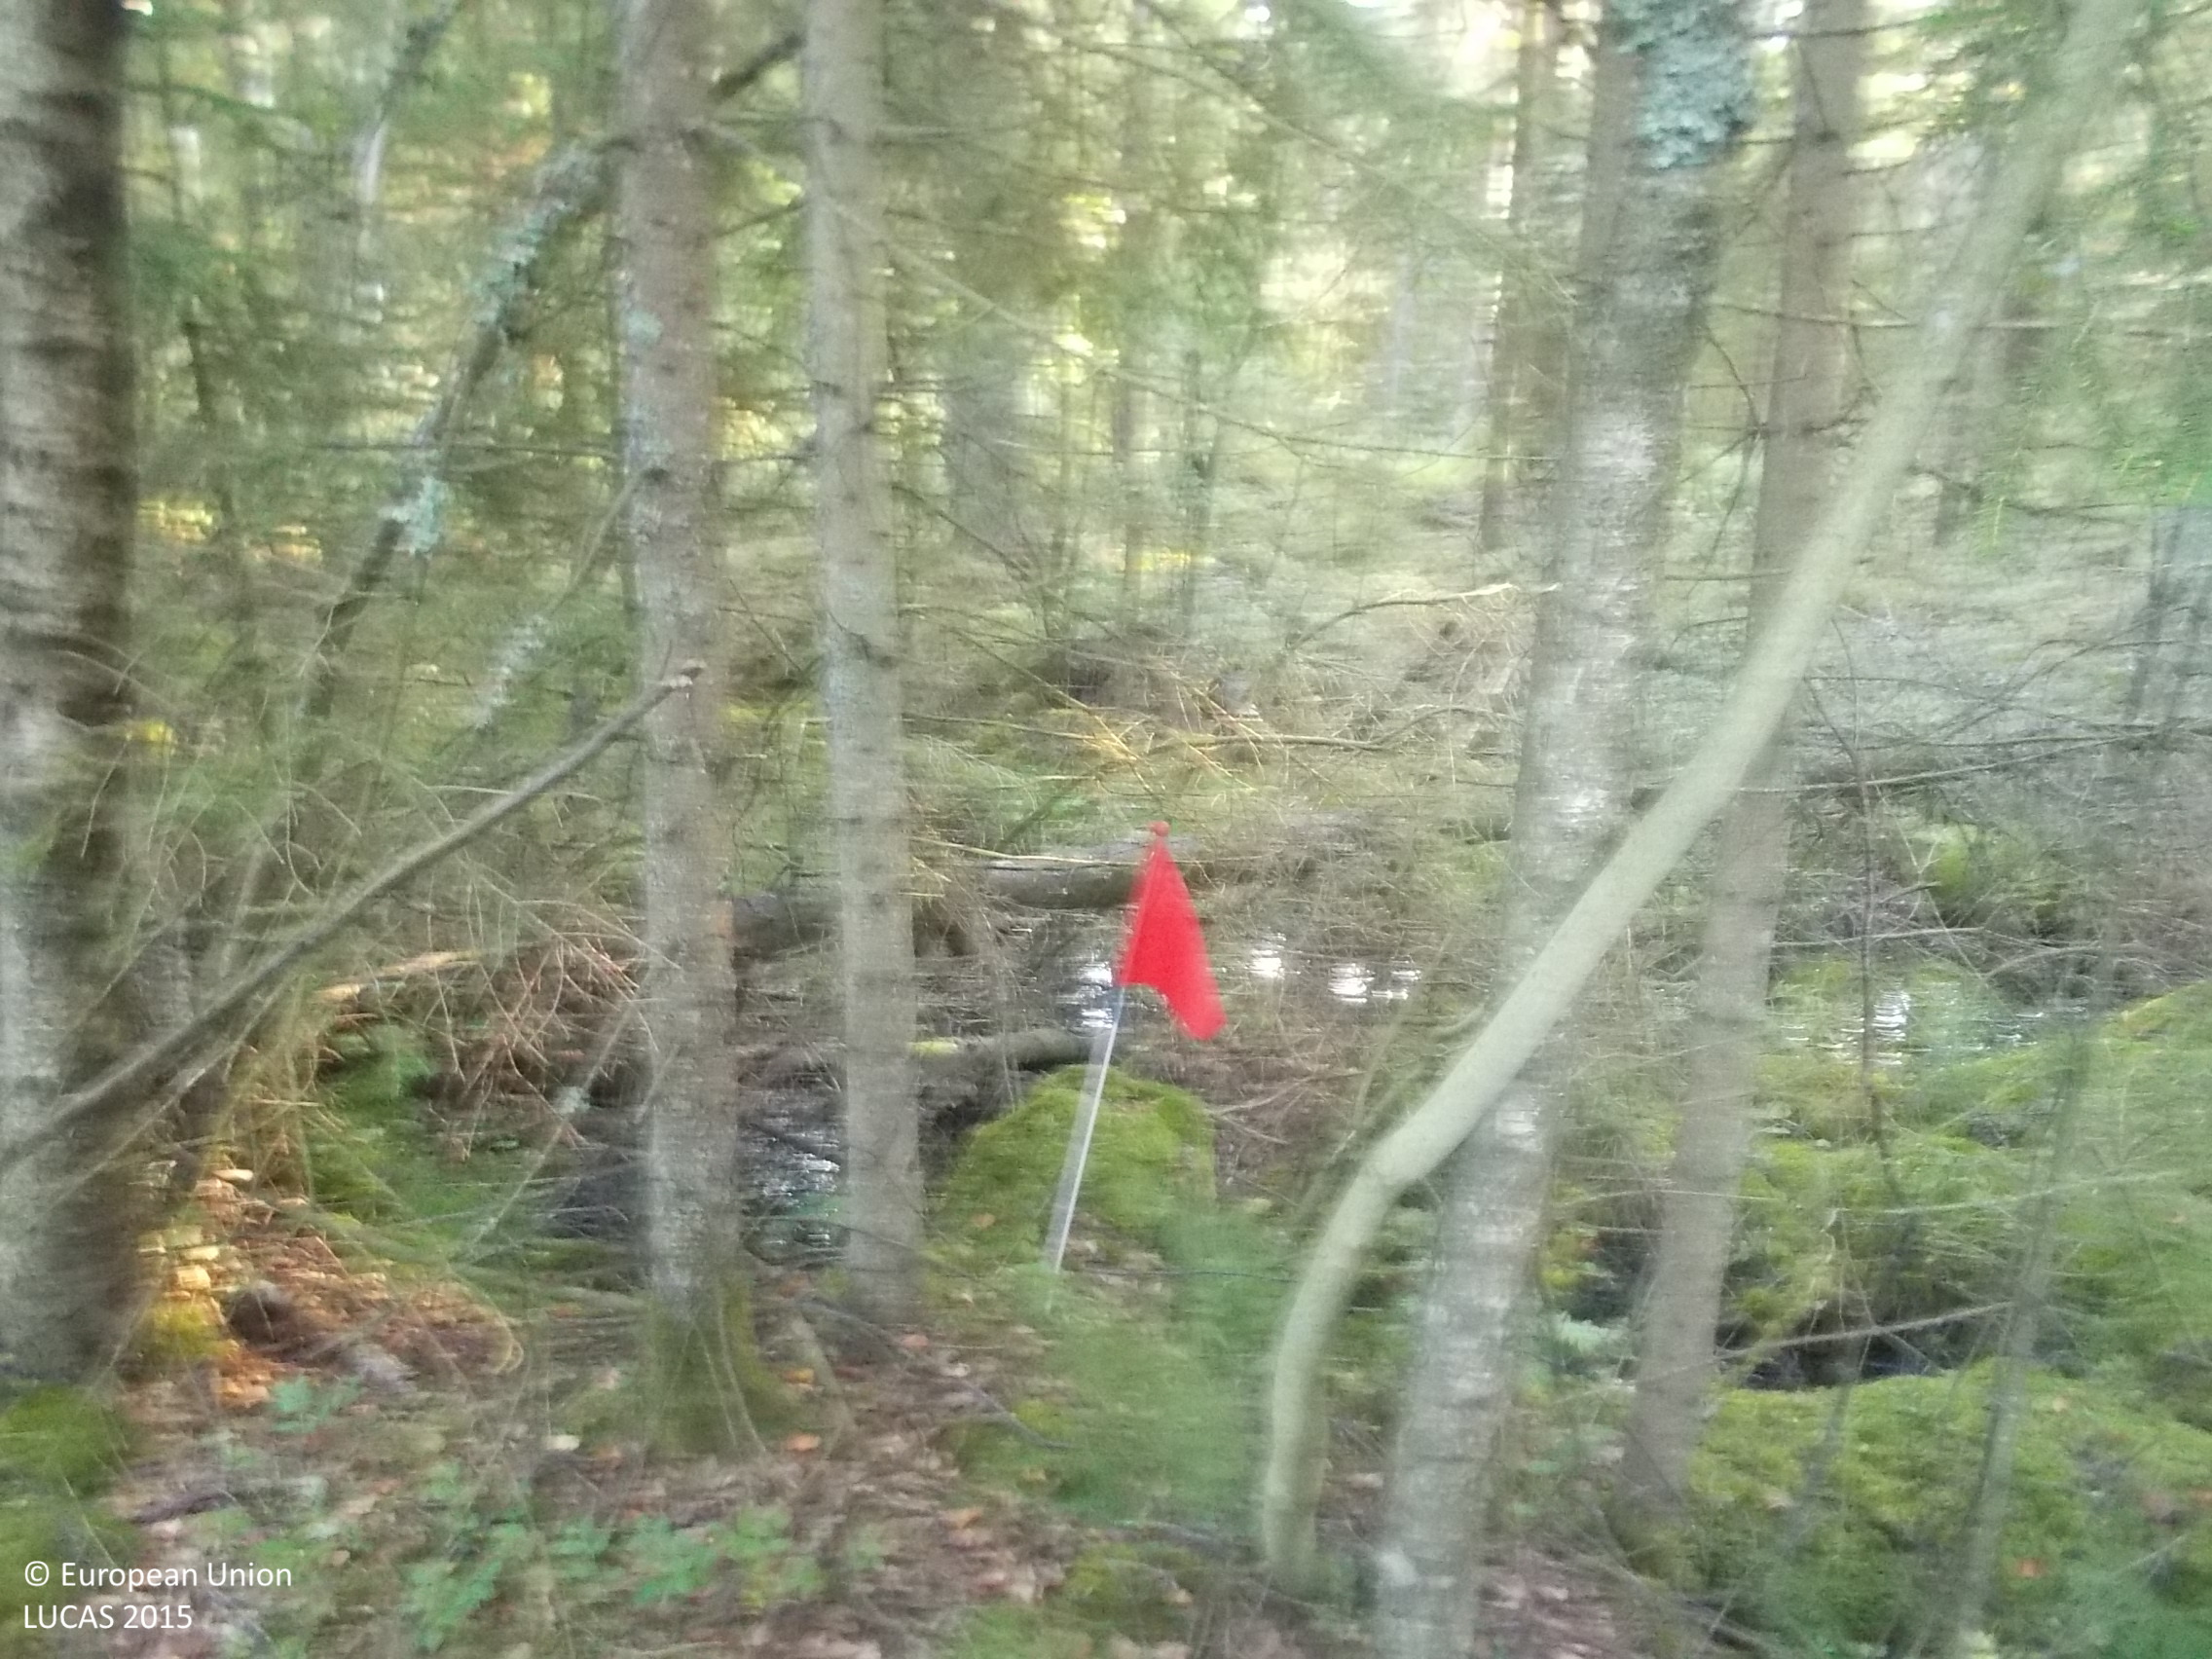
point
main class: Woodland
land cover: Spruce dominated coniferous woodland
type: boreal forest
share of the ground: > 75 %
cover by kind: coniferous forest trees 85 %, broadleaved forest trees 5 %, shrubs 5 %, lichens and mosses 5 %
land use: Forestry
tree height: > 5 m
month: August
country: SE
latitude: 57.4440
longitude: 13.1782
